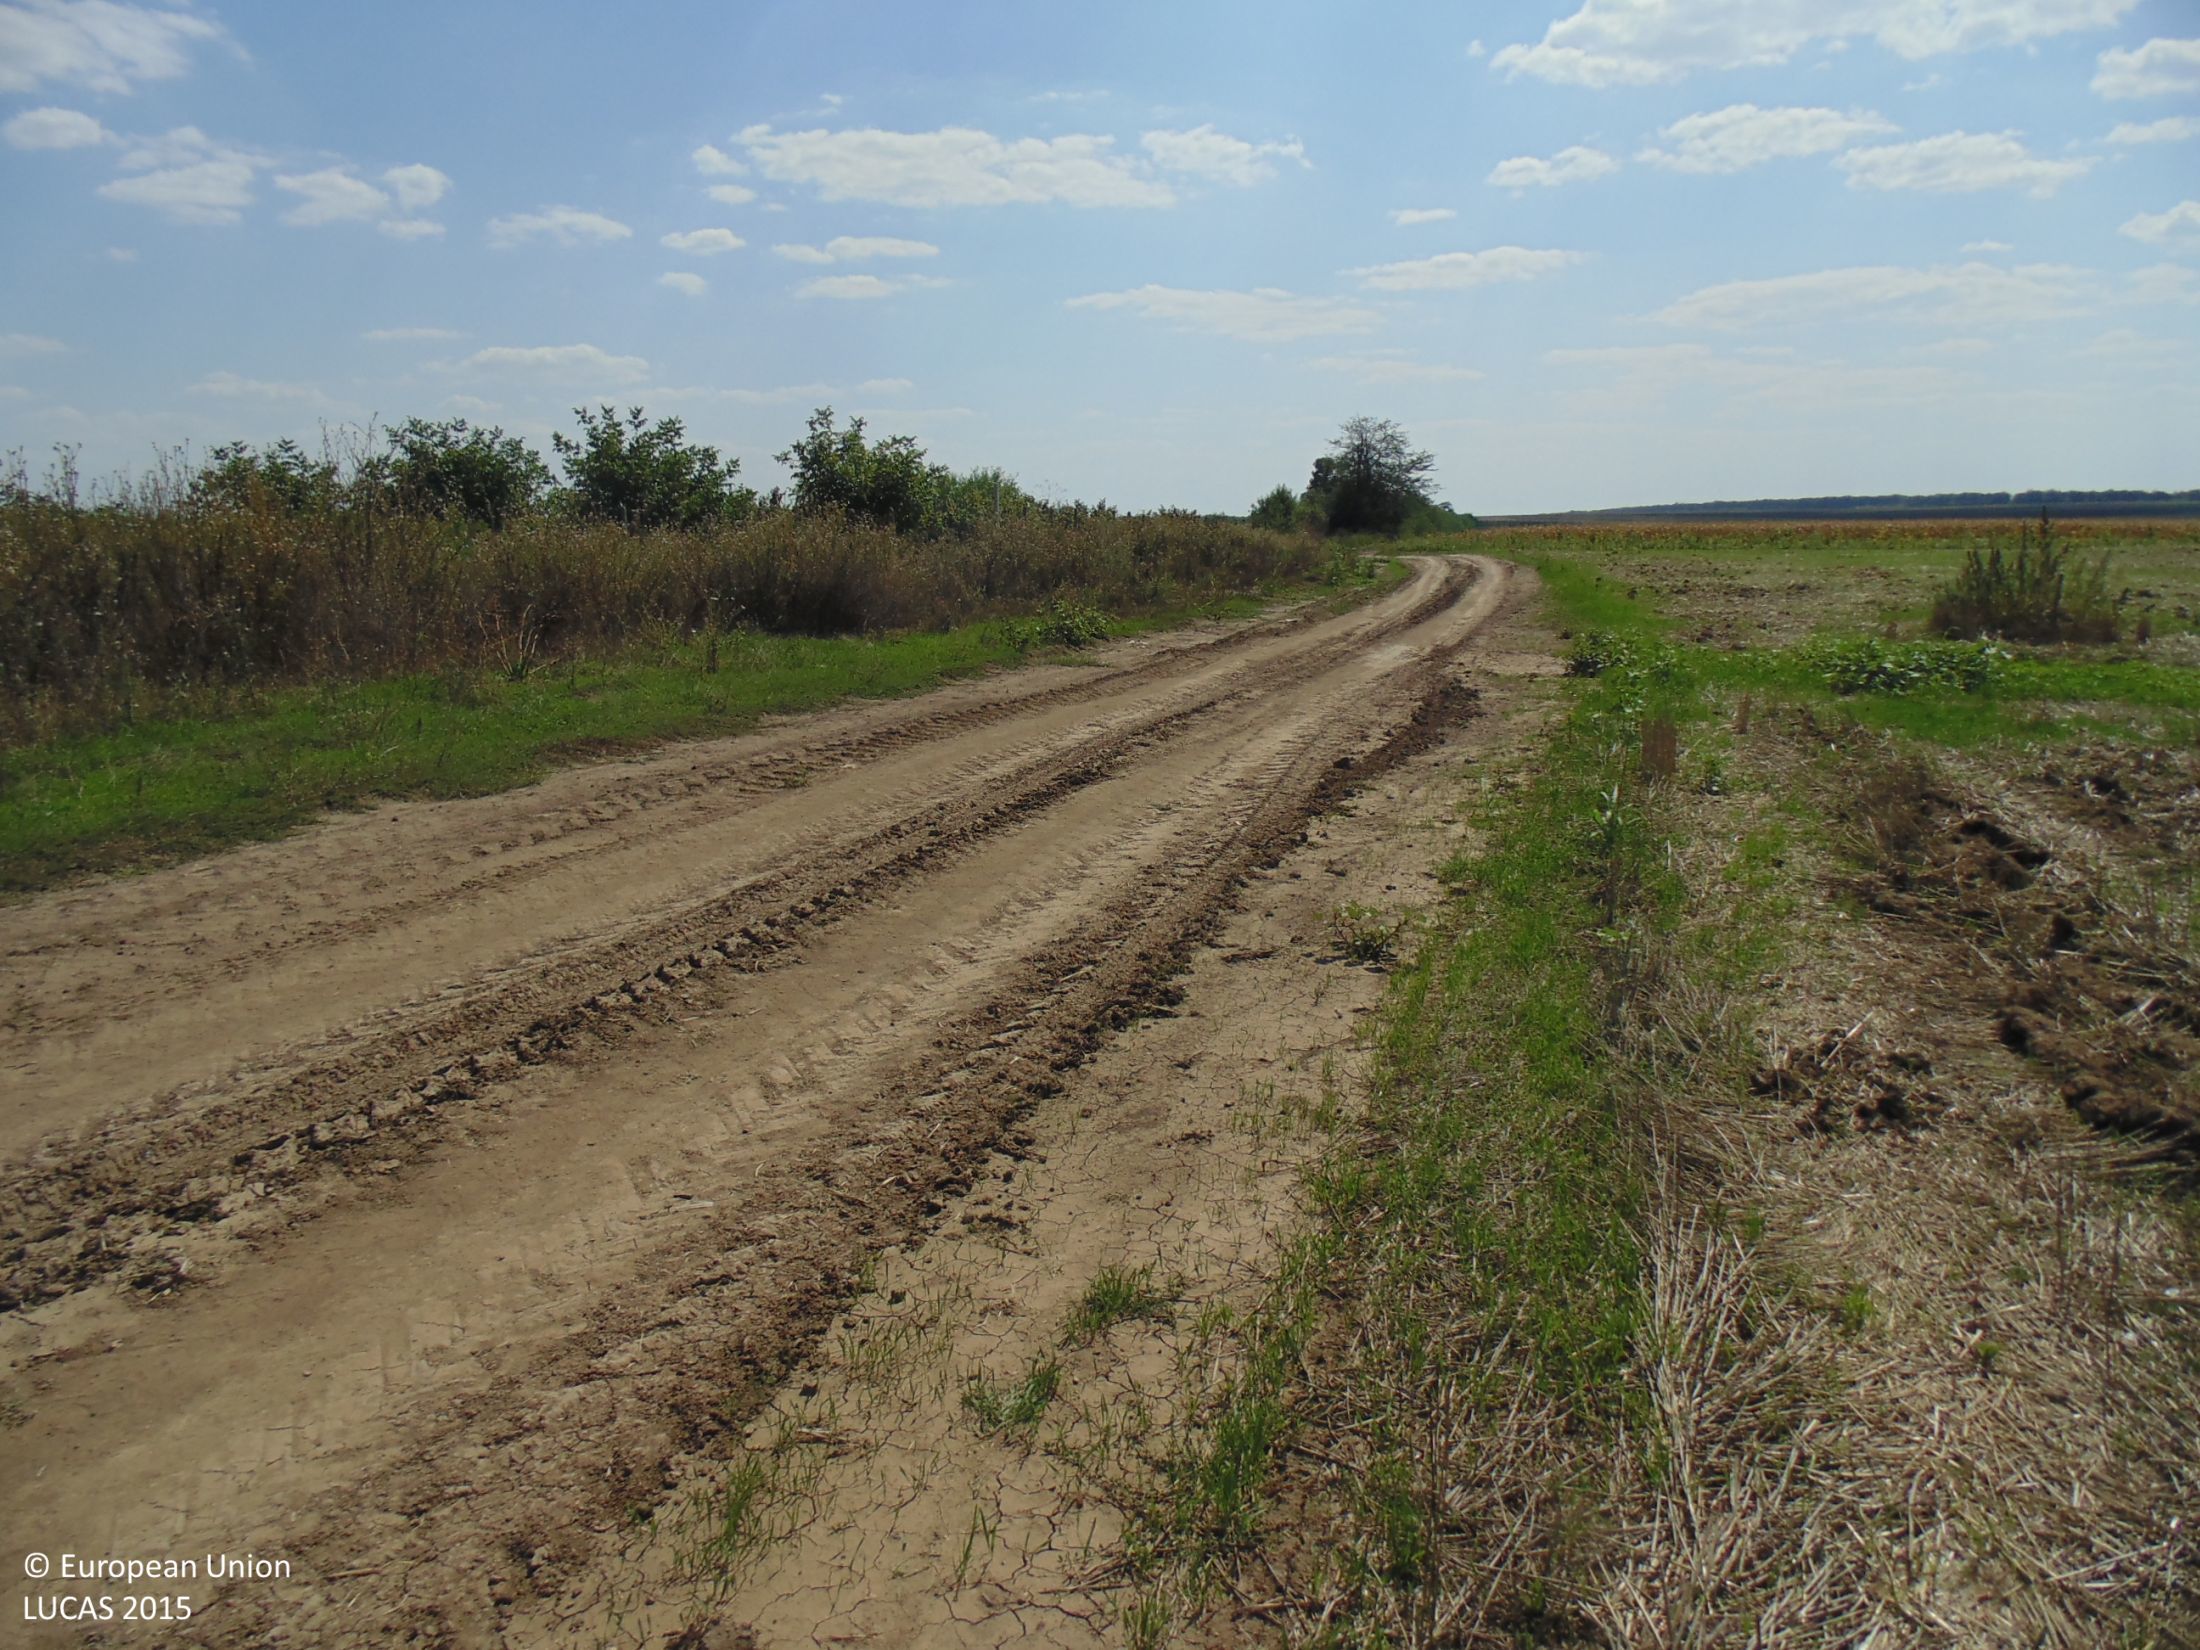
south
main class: Cropland
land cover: Common wheat
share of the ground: 10 - 25 %
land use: Agriculture (excluding fallow land and kitchen gardens)
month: August
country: BG
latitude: 43.6963
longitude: 27.2875
